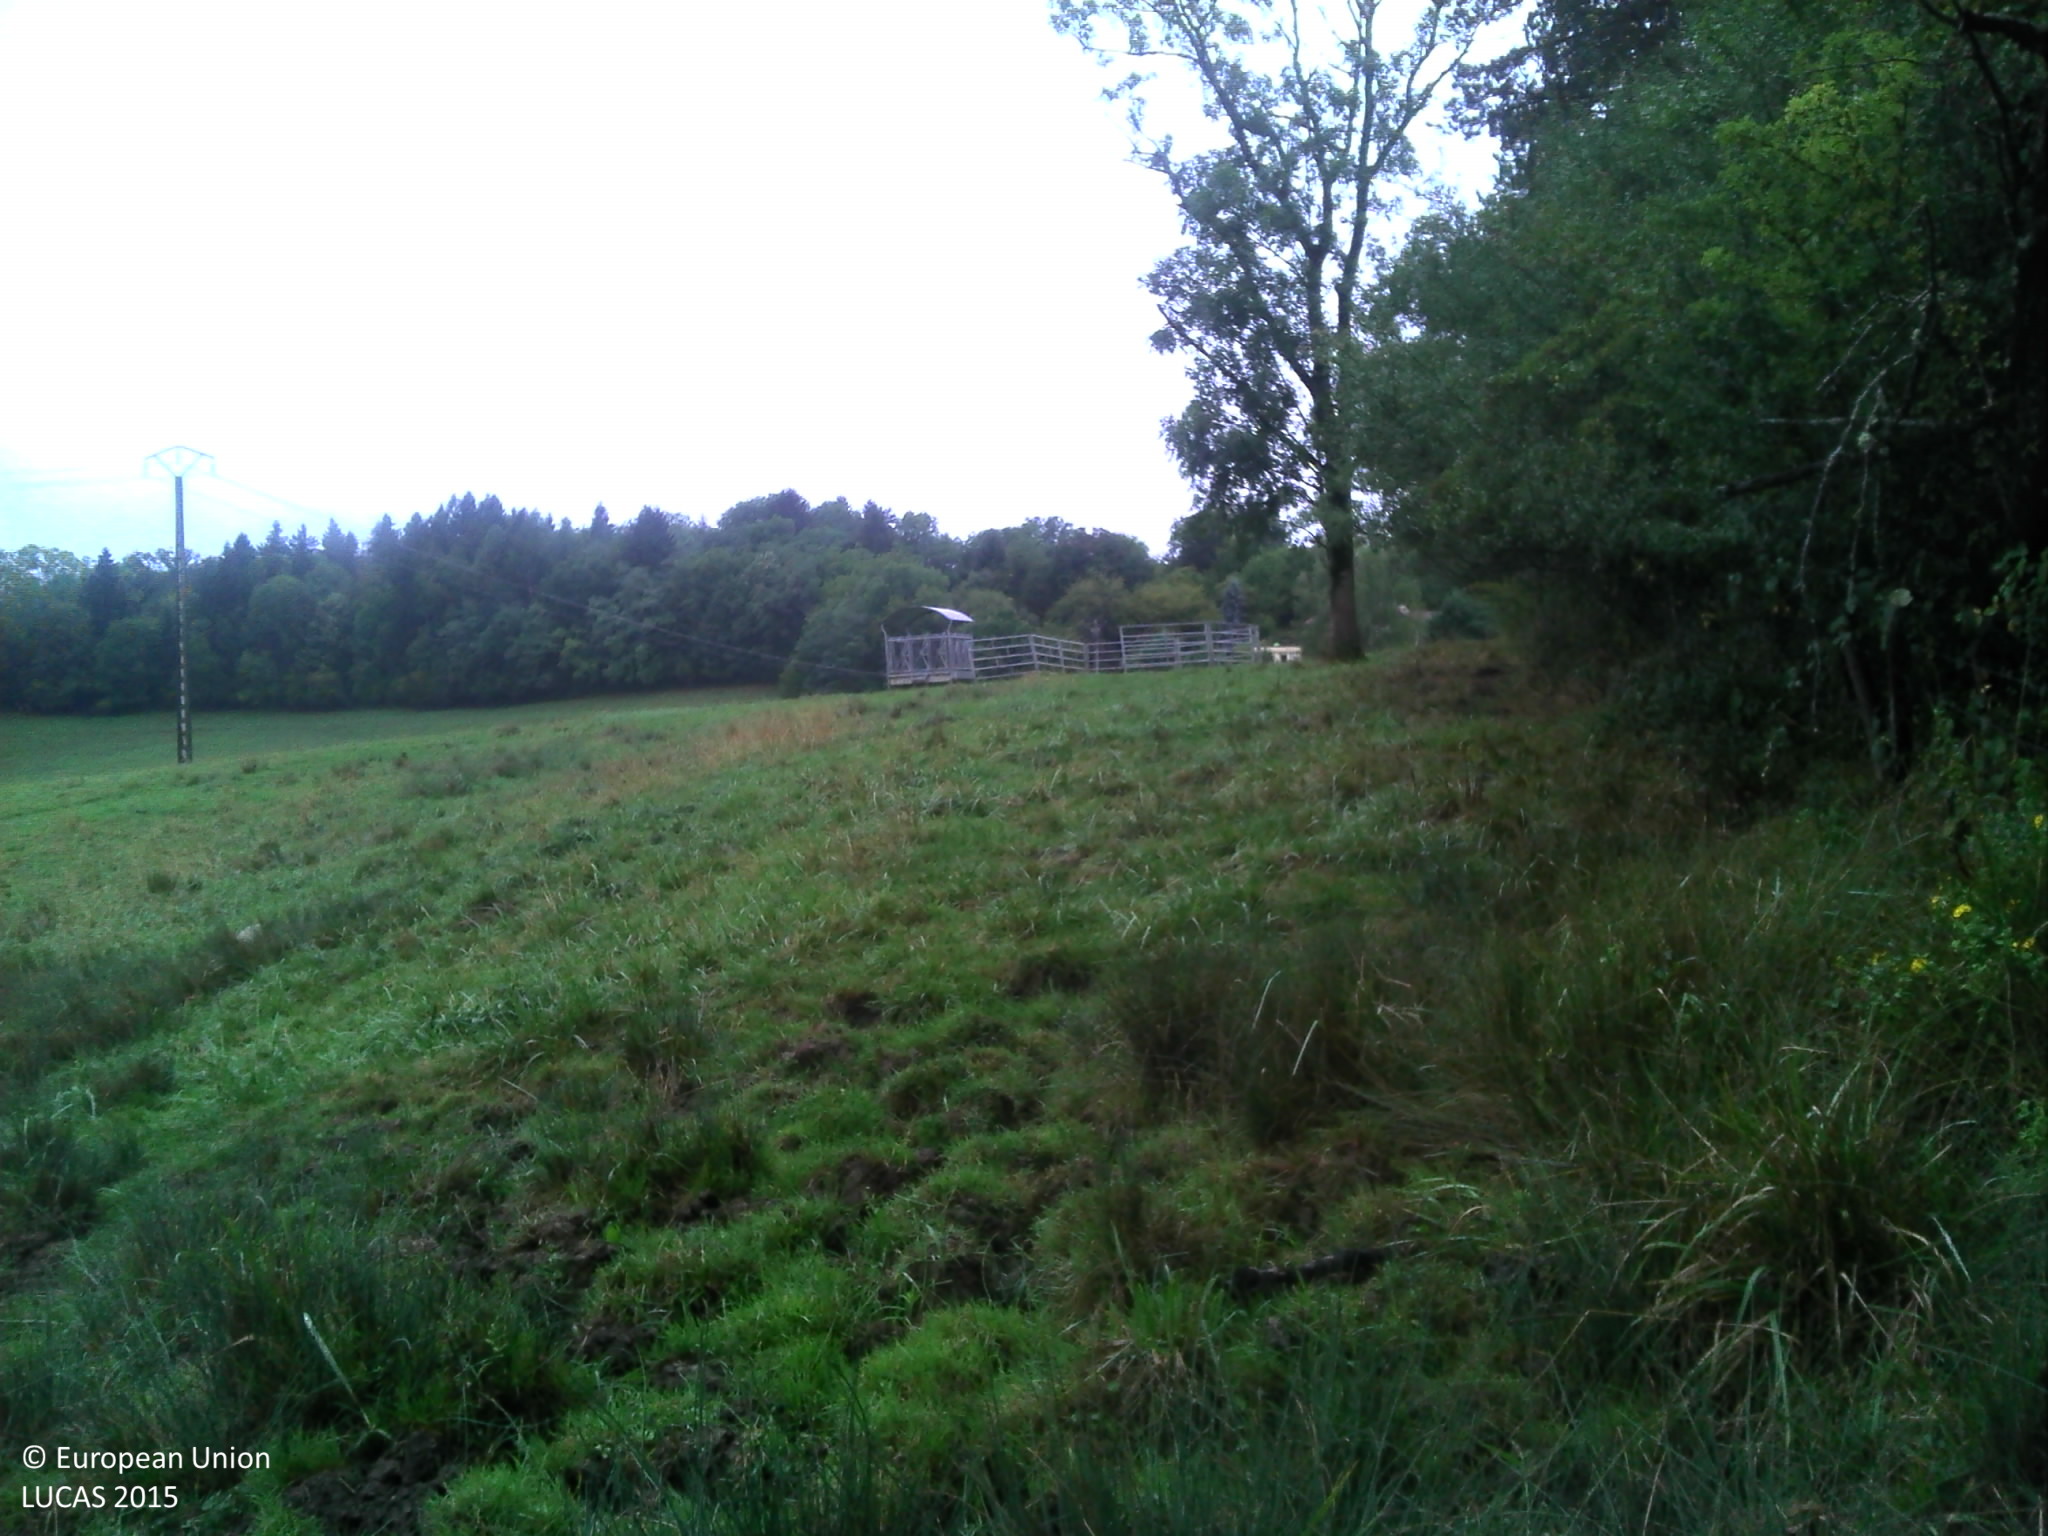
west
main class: Woodland
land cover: Broadleaved woodland
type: mesophytic deciduous forest
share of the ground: > 75 %
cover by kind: broadleaved forest trees 70 %, shrubs 20 %, herbaceous plants 10 %
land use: Semi-natural and natural areas not in use
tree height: > 5 m
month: September
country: FR
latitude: 47.2159
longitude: 6.0537
